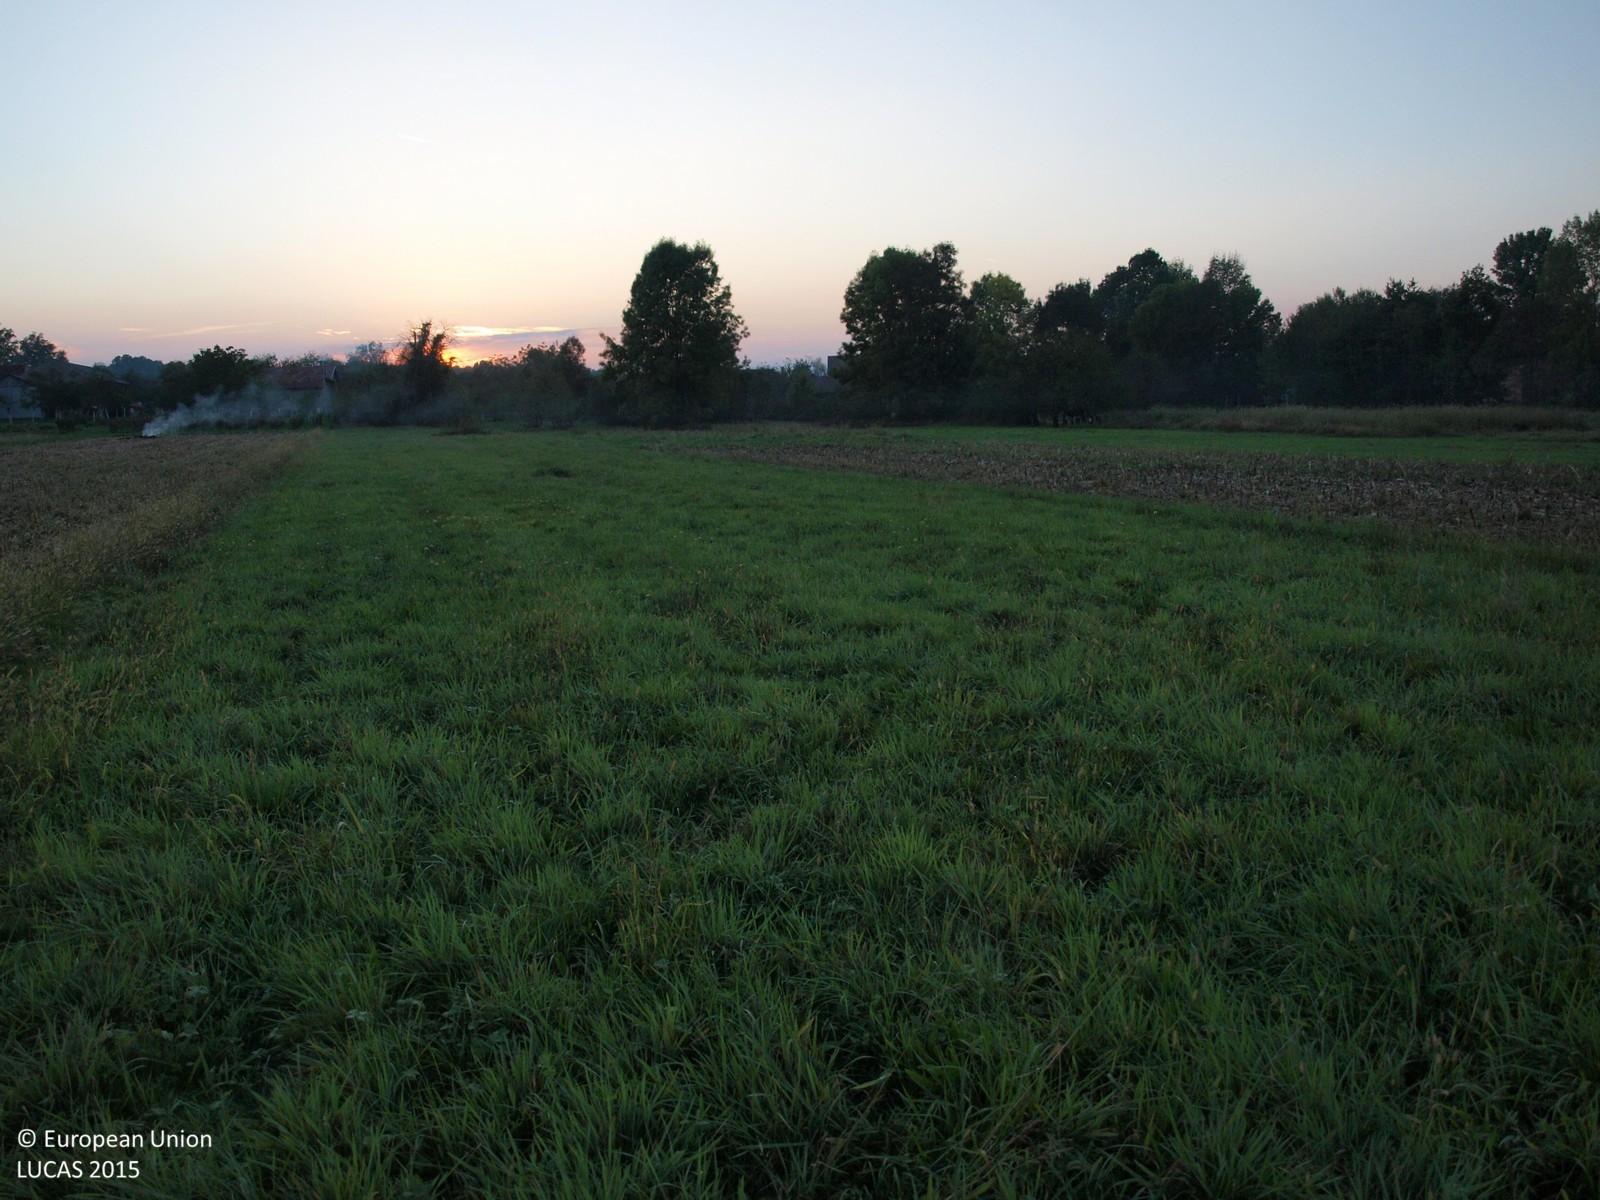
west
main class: Grassland
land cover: Grassland without tree/shrub cover
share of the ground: > 75 %
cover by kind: herbaceous plants 100 %
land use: Agriculture (excluding fallow land and kitchen gardens)
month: October
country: HR
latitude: 45.4846
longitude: 16.2026
